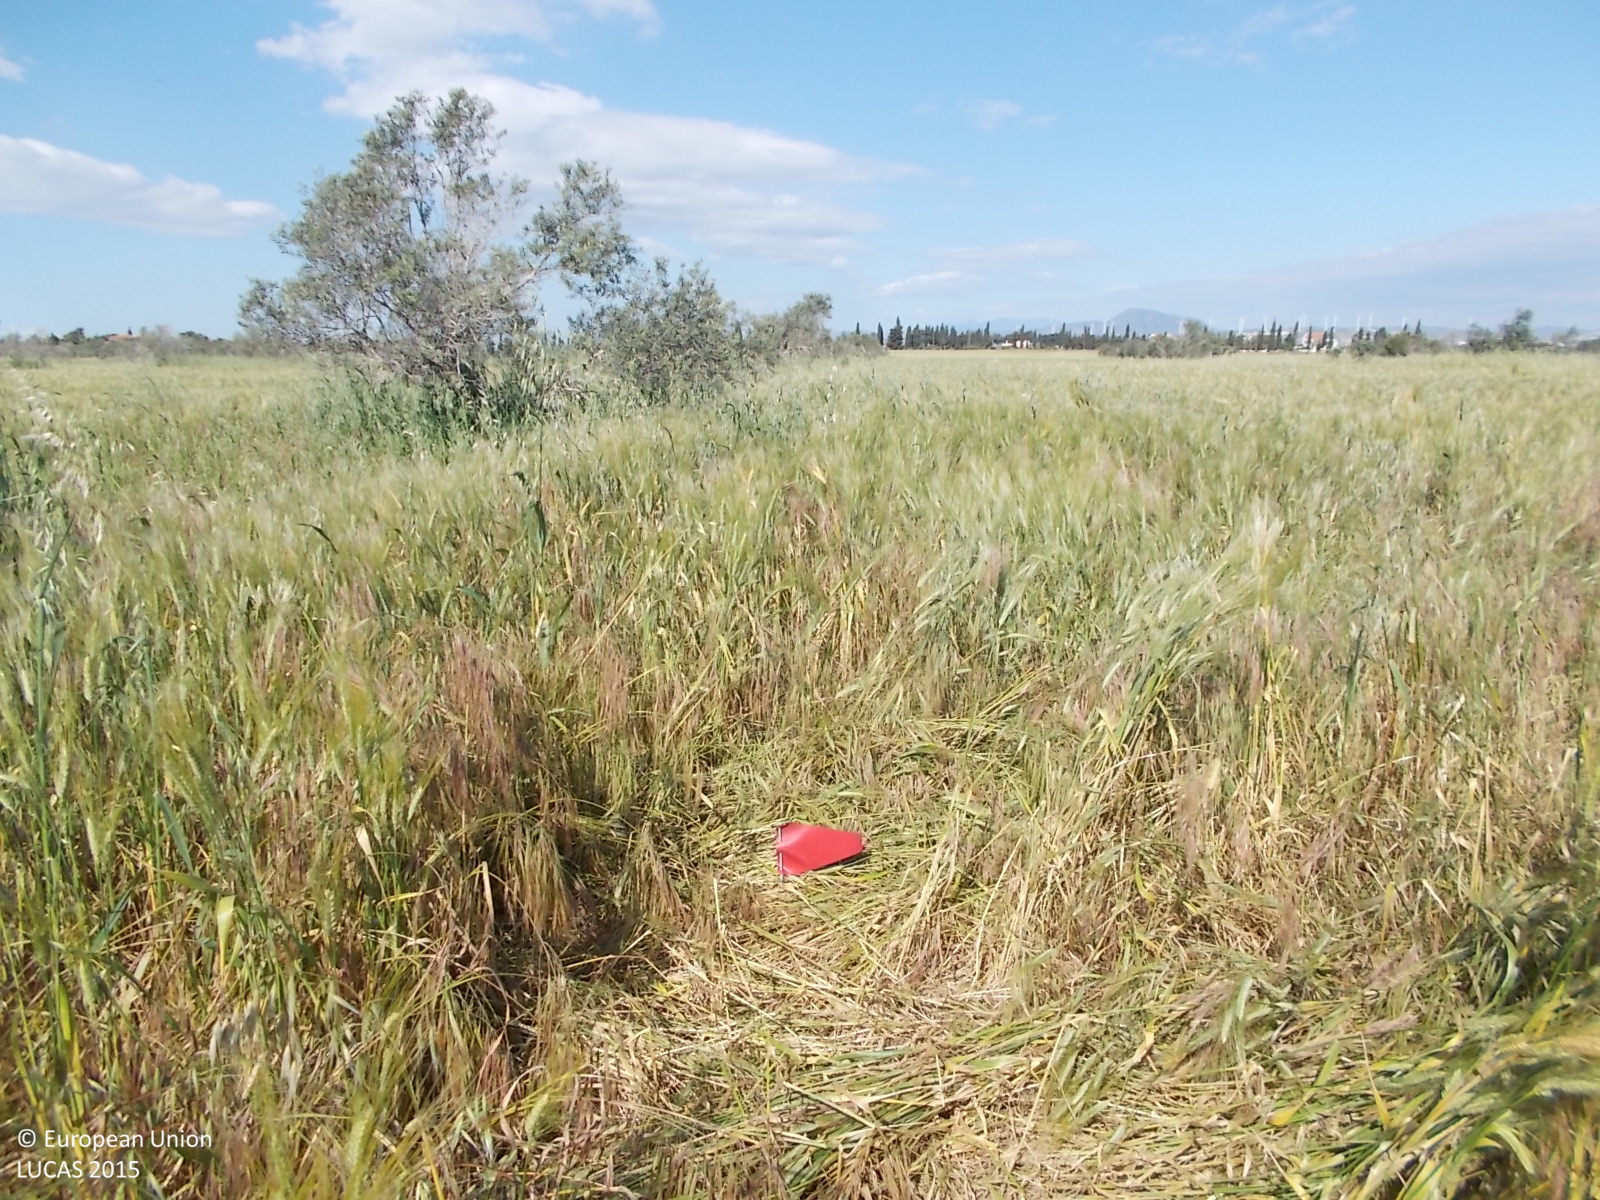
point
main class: Cropland
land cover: Mixed cereals for fodder
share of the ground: > 75 %
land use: Agriculture (excluding fallow land and kitchen gardens)
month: April
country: CY
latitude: 34.8431
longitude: 33.6068
